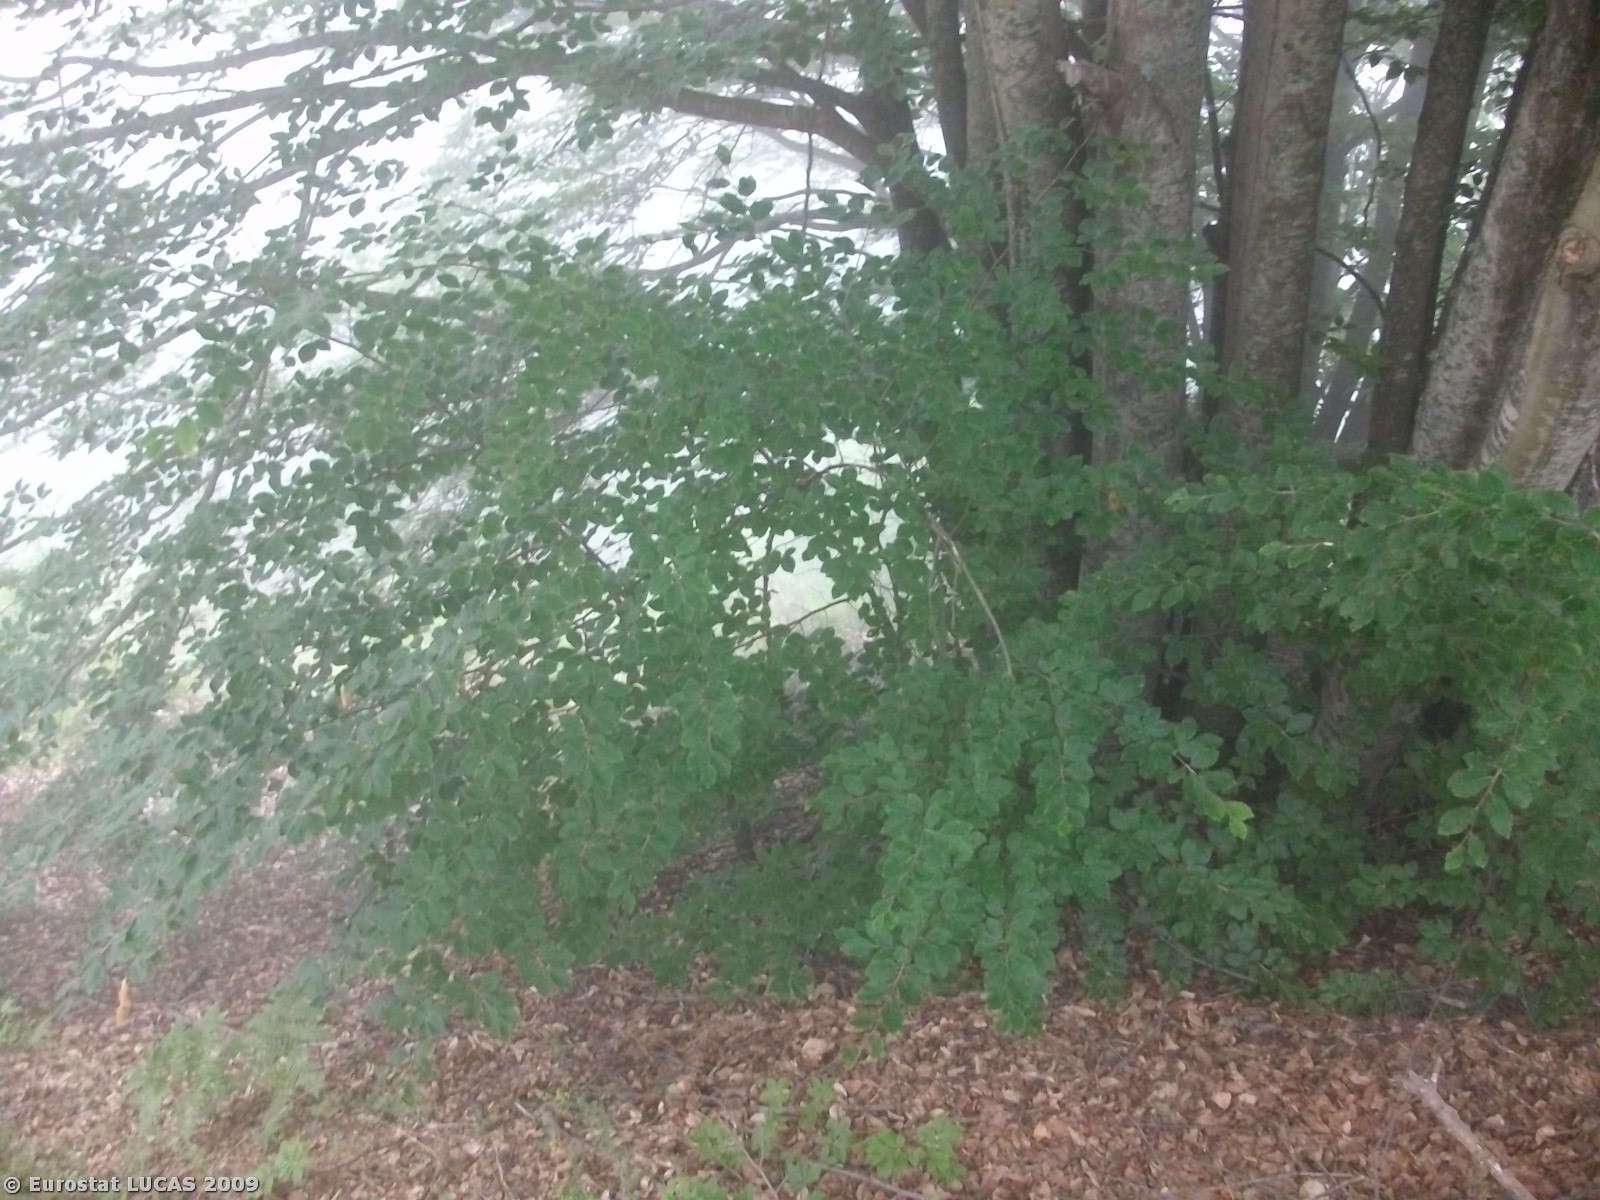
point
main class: Woodland
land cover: Broadleaved woodland
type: beech forest
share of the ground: > 75 %
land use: Forestry
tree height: > 5 m
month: May
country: GR
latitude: 39.8501
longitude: 22.6289
